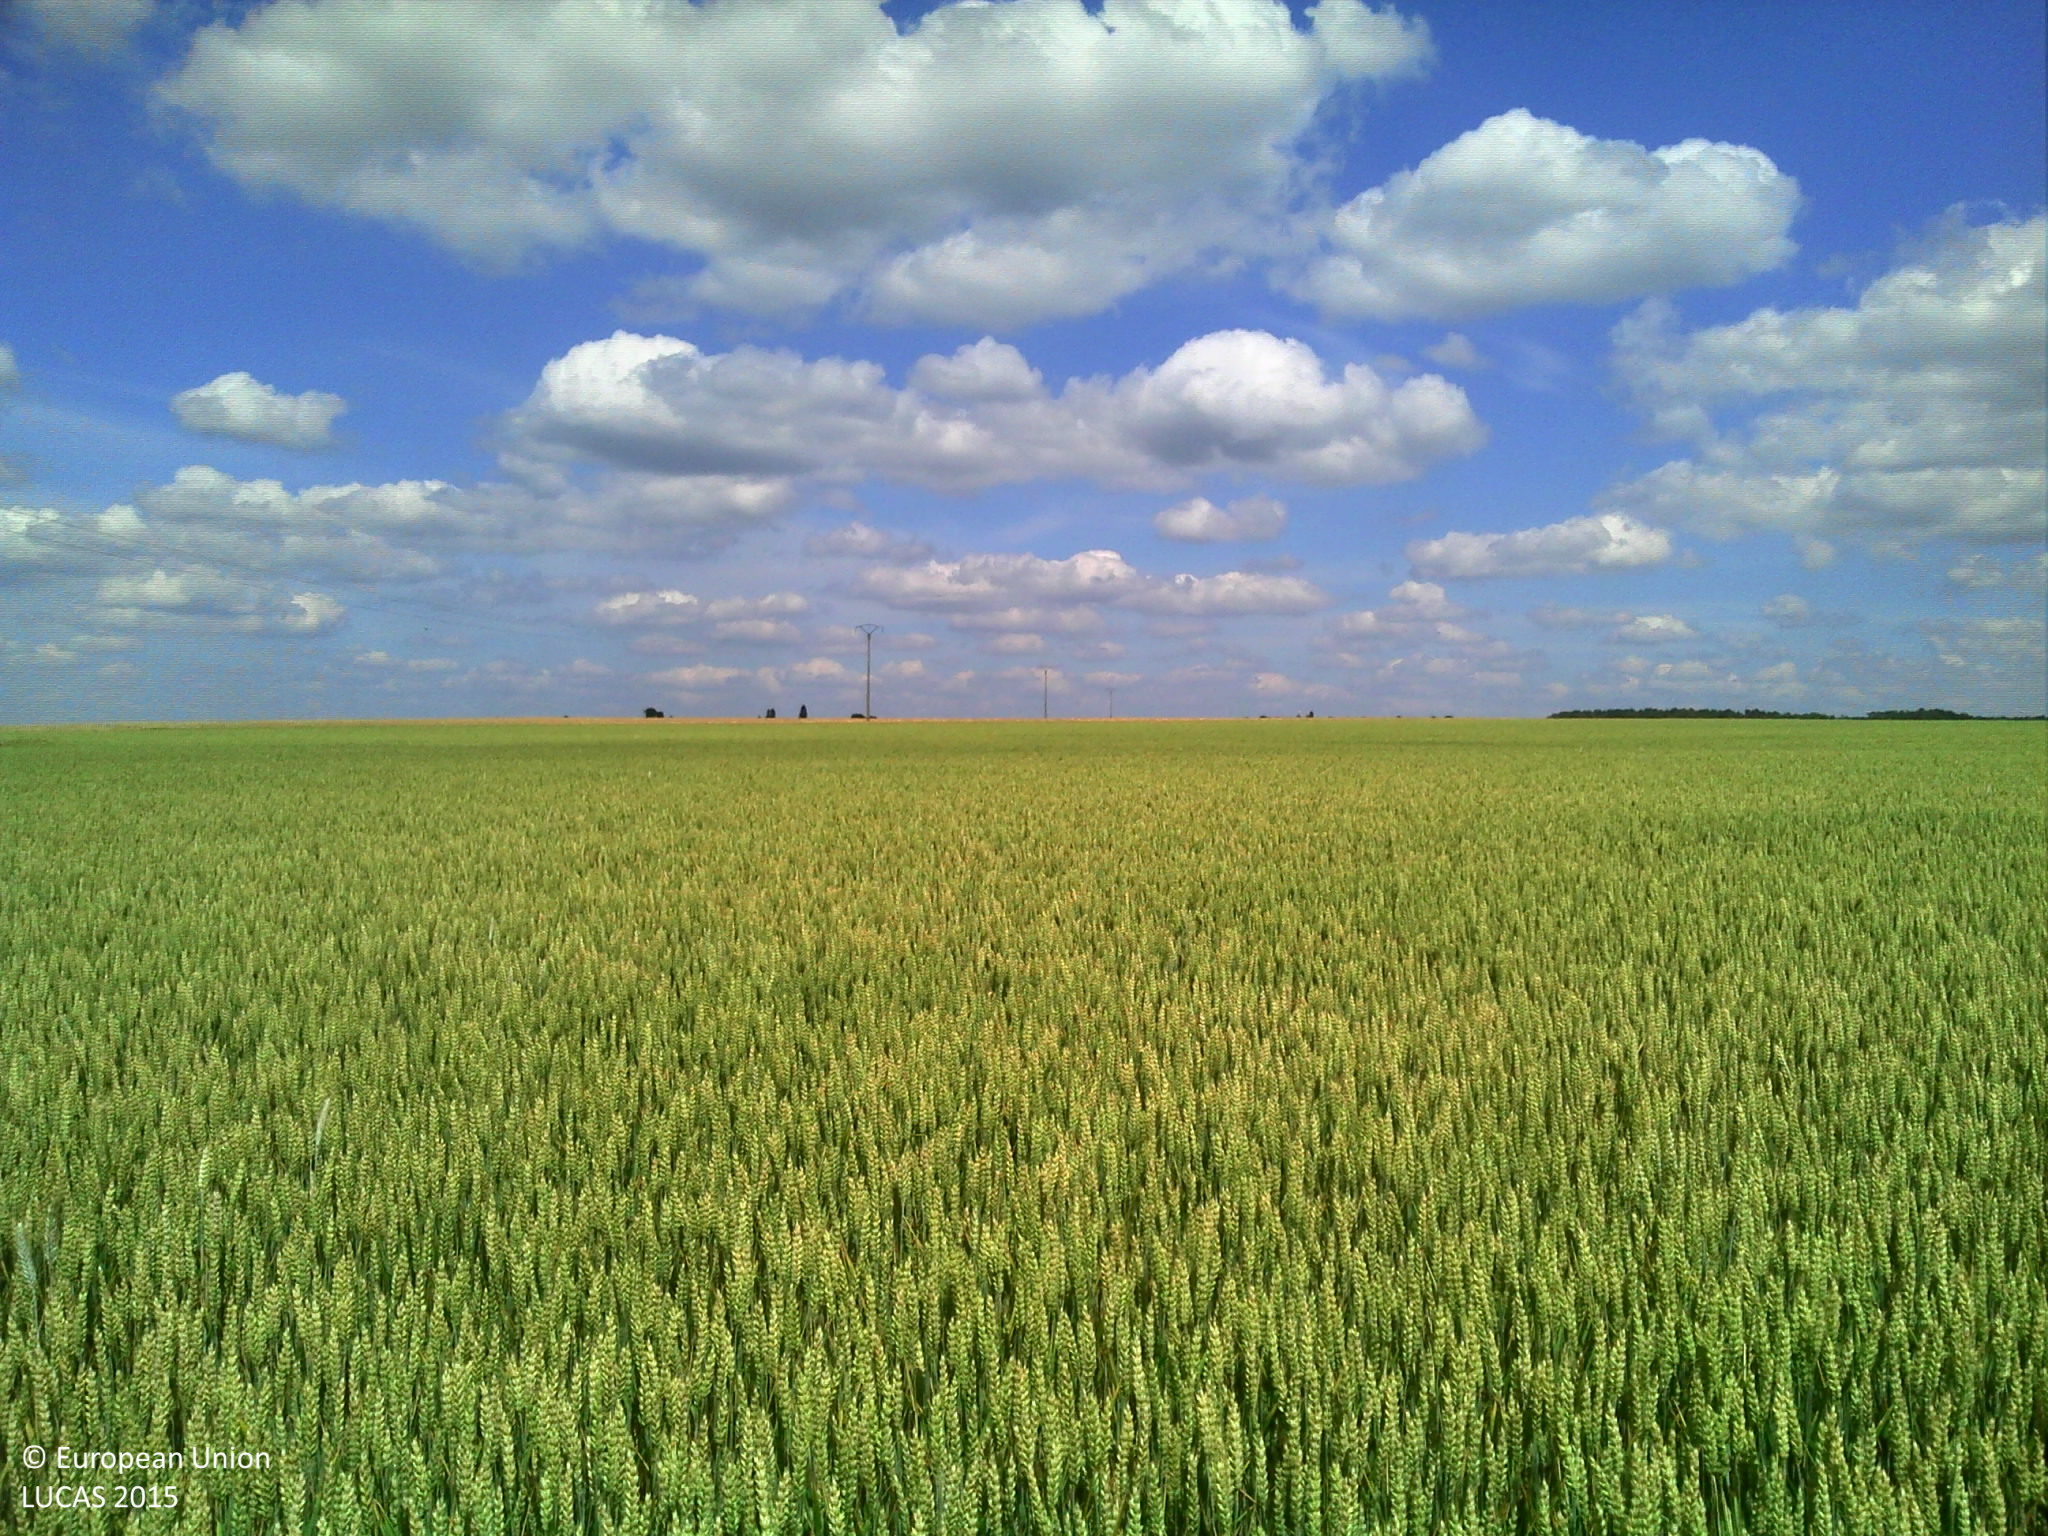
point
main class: Cropland
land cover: Common wheat
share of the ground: > 75 %
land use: Agriculture (excluding fallow land and kitchen gardens)
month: June
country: FR
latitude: 49.0484
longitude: 5.9085
